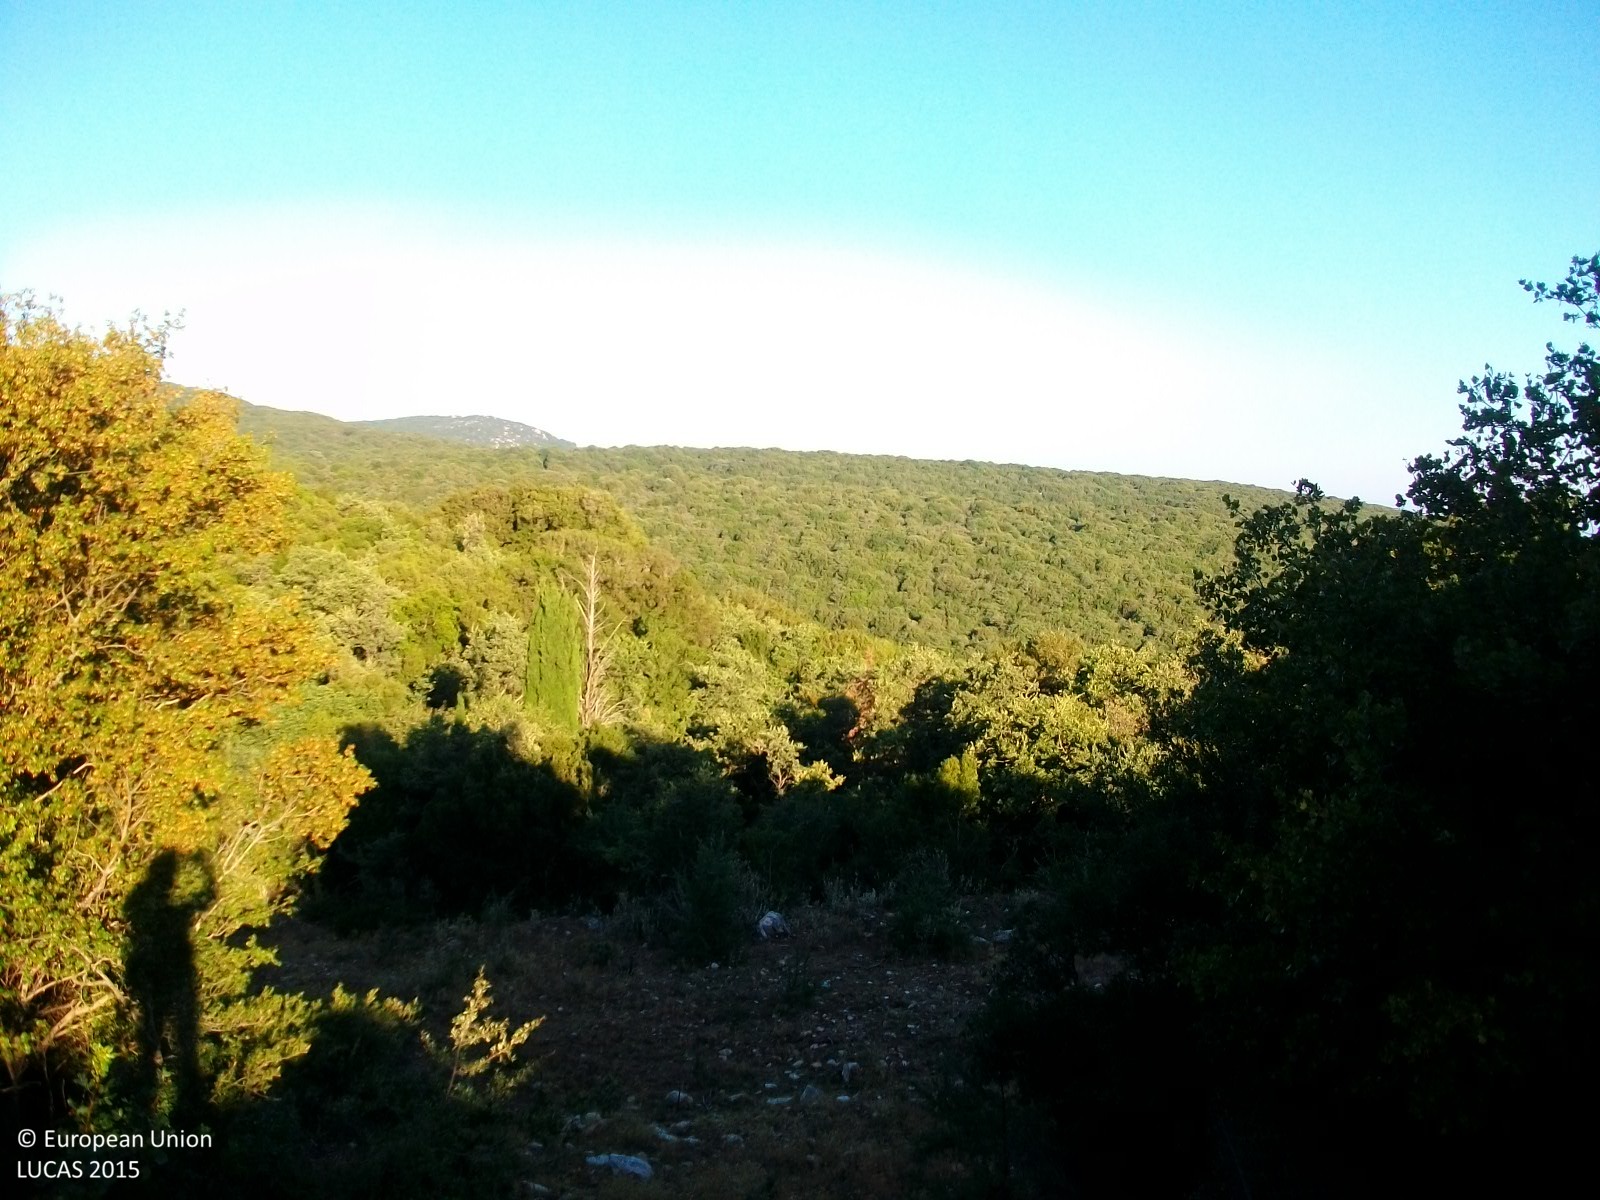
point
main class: Woodland
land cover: Broadleaved woodland
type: broadleaved evergreen forest
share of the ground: > 75 %
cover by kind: broadleaved forest trees 100 %
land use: Semi-natural and natural areas not in use
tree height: > 5 m
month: July
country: GR
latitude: 36.9469
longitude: 21.8652
